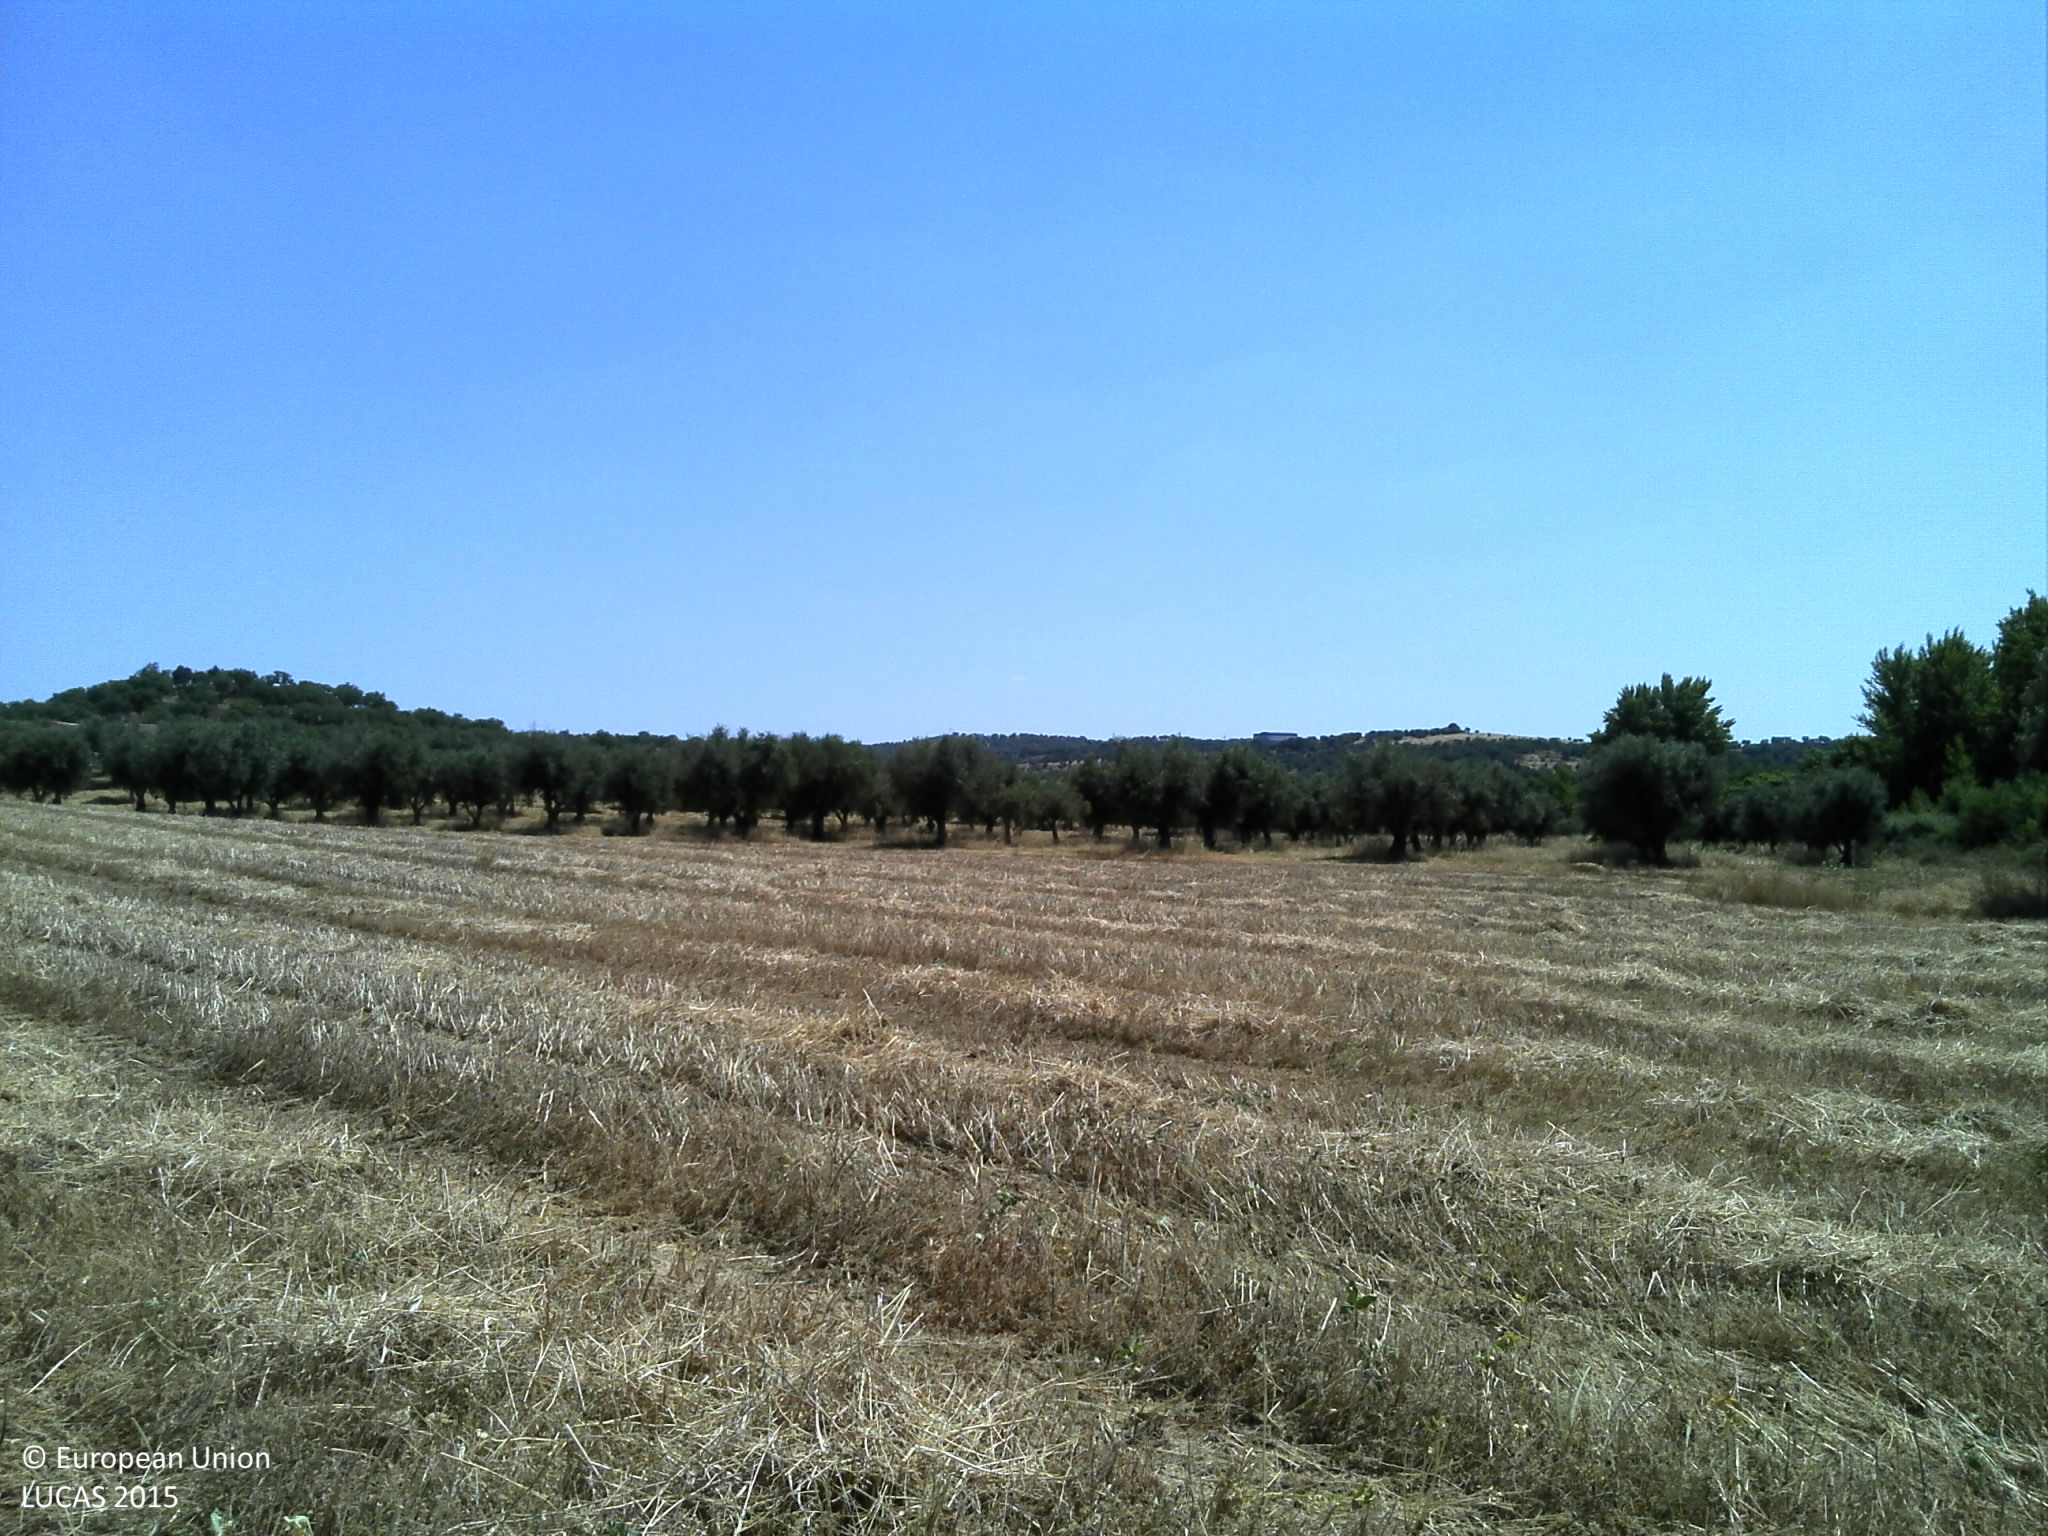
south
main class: Cropland
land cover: Other leguminous and mixtures for fodder
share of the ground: < 10 %
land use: Agriculture (excluding fallow land and kitchen gardens)
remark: Harvested field
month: June
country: PT
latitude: 38.2648
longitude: -7.9441
